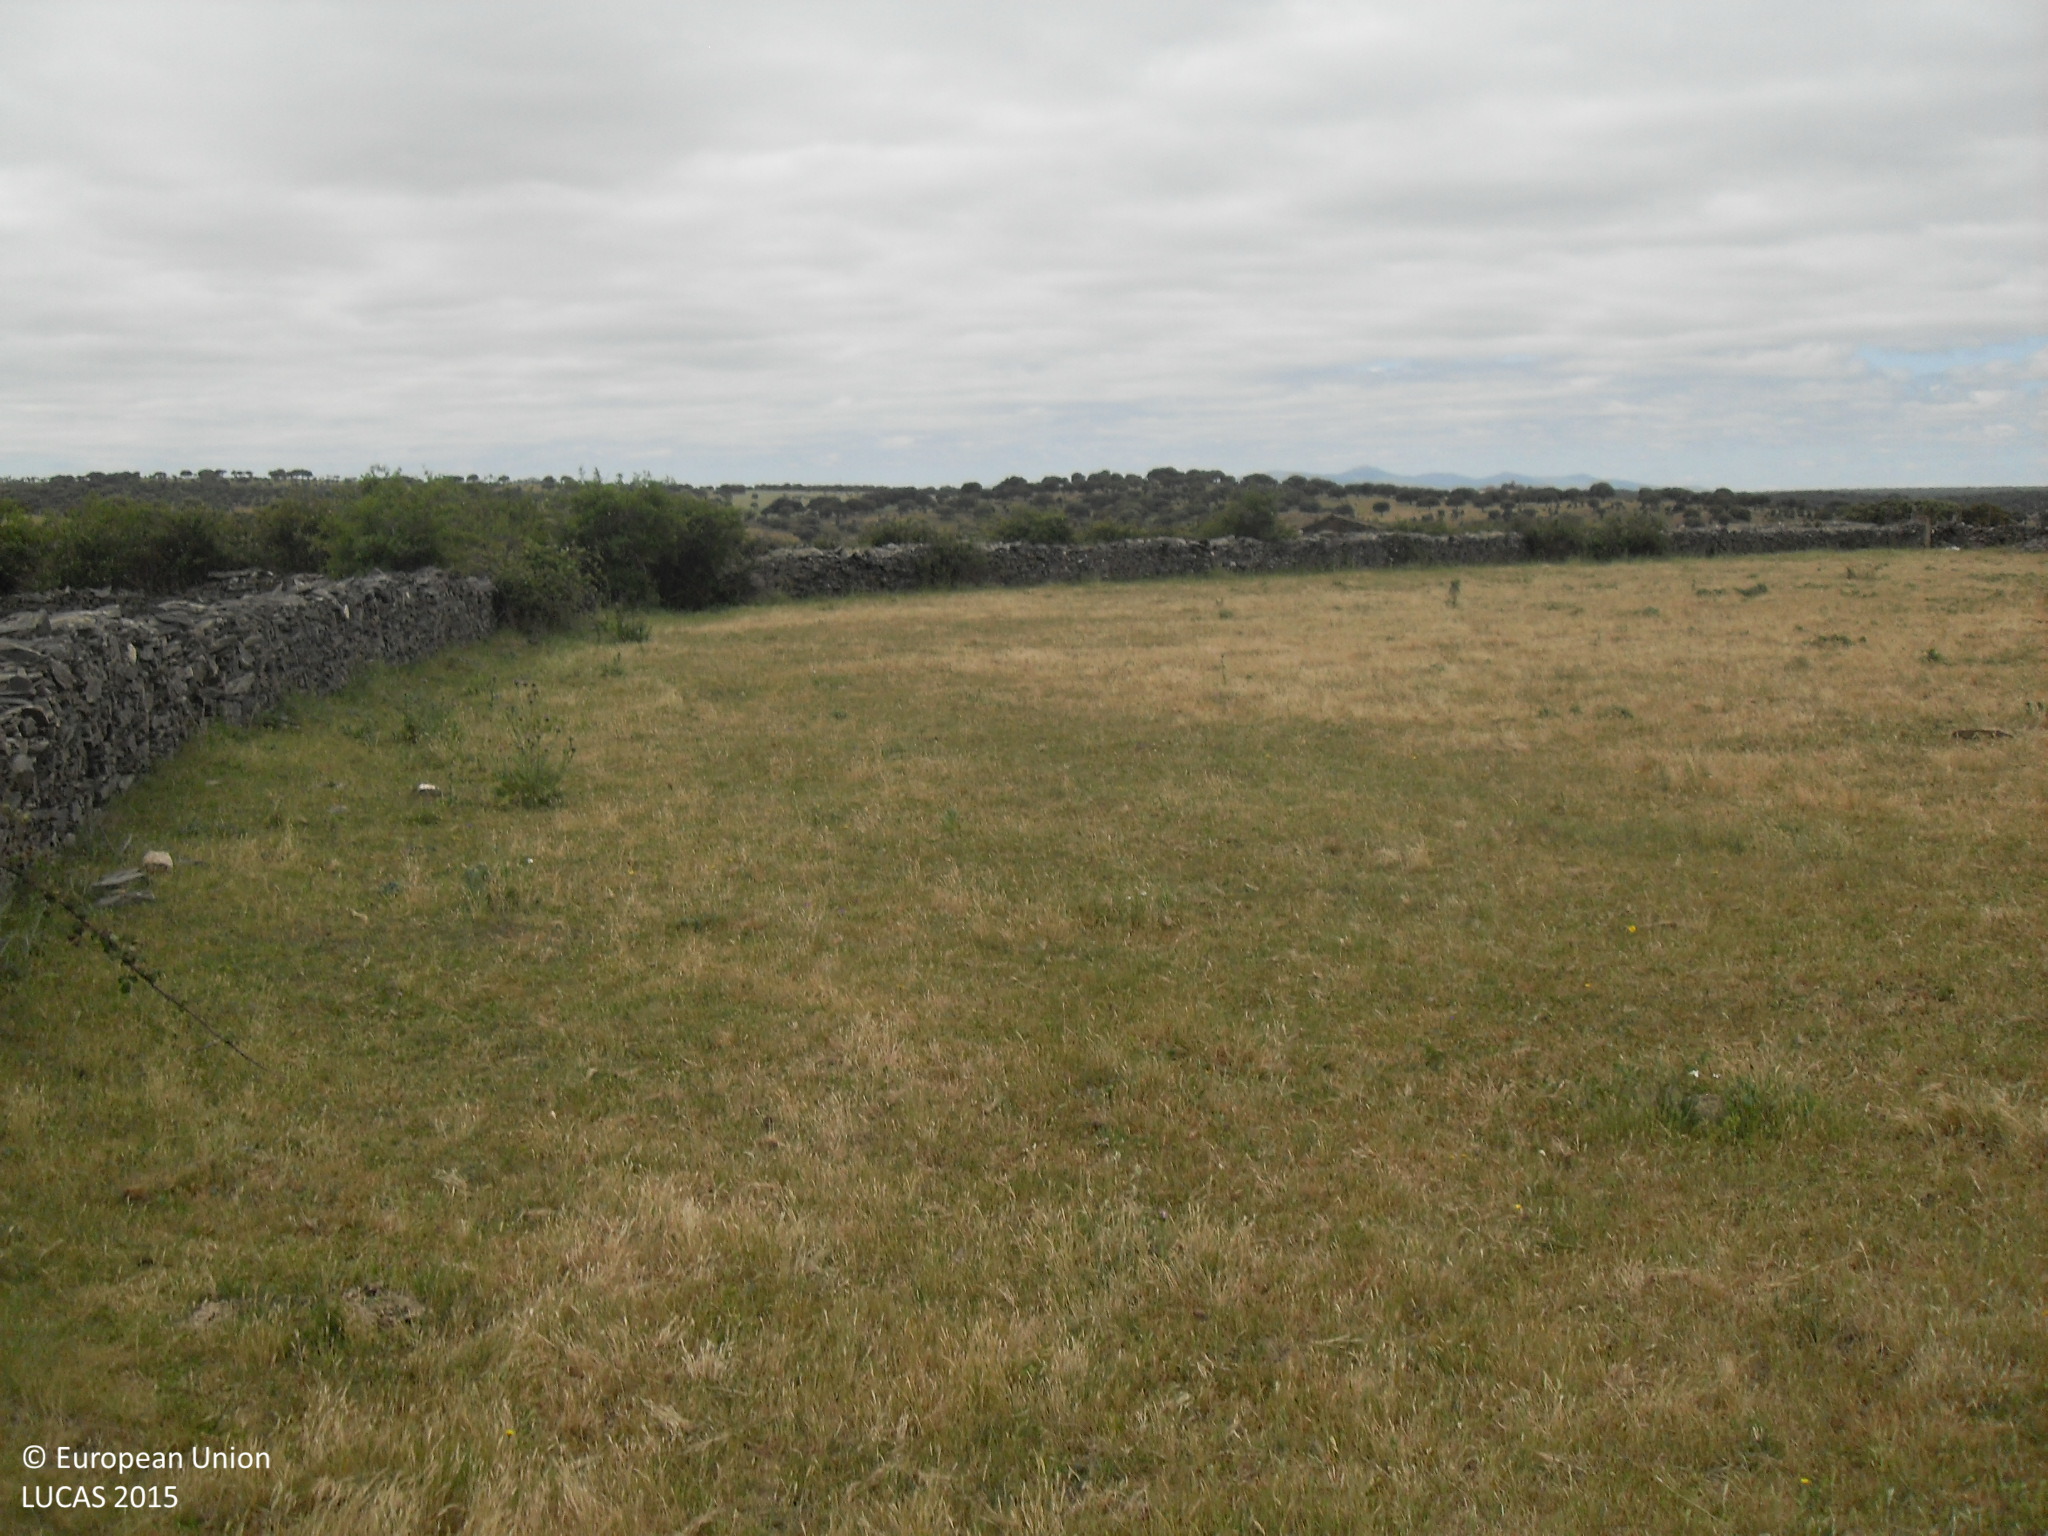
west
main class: Grassland
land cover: Grassland without tree/shrub cover
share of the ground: > 75 %
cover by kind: herbaceous plants 100 %
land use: Agriculture (excluding fallow land and kitchen gardens)
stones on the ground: 10 - 25 %
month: May
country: ES
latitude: 40.6397
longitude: -5.6448
